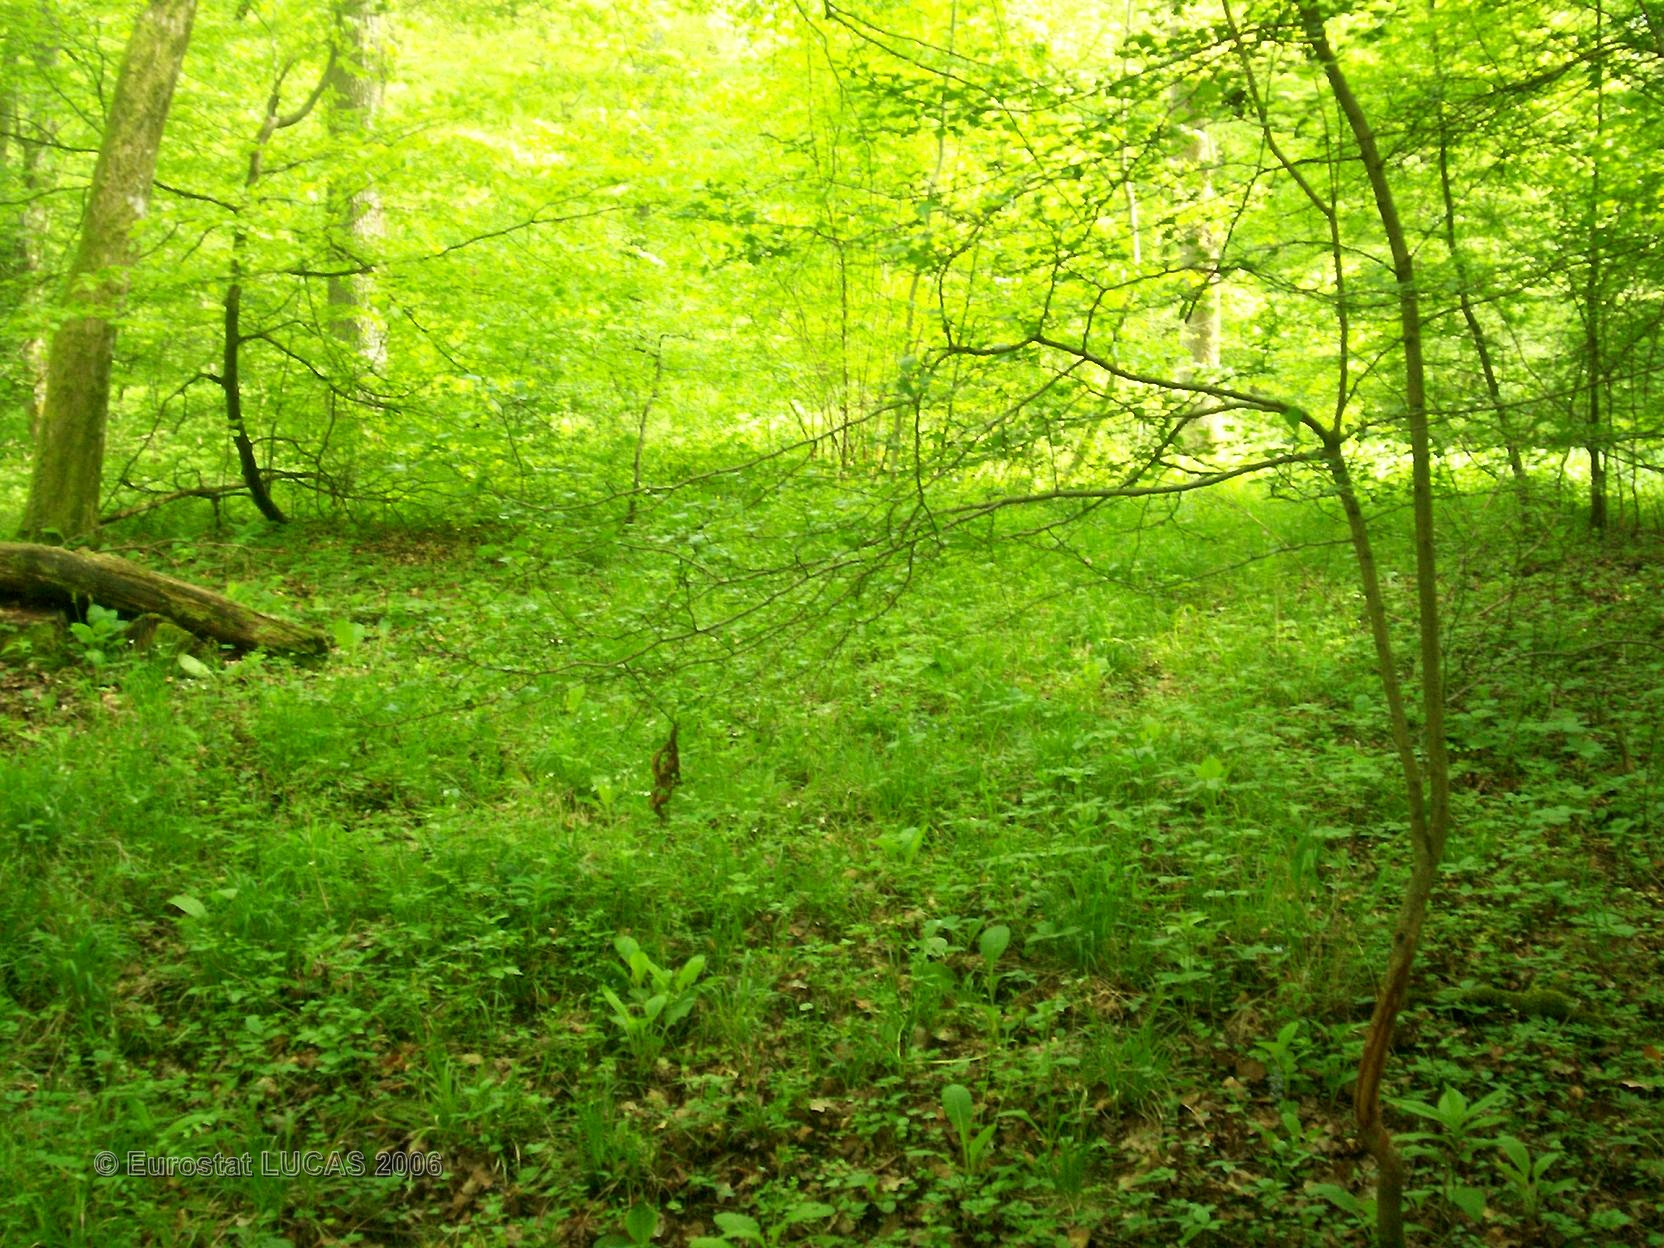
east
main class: Woodland
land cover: Mixed forest
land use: Forestry
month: May
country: FR
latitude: 49.3904
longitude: 6.4316
